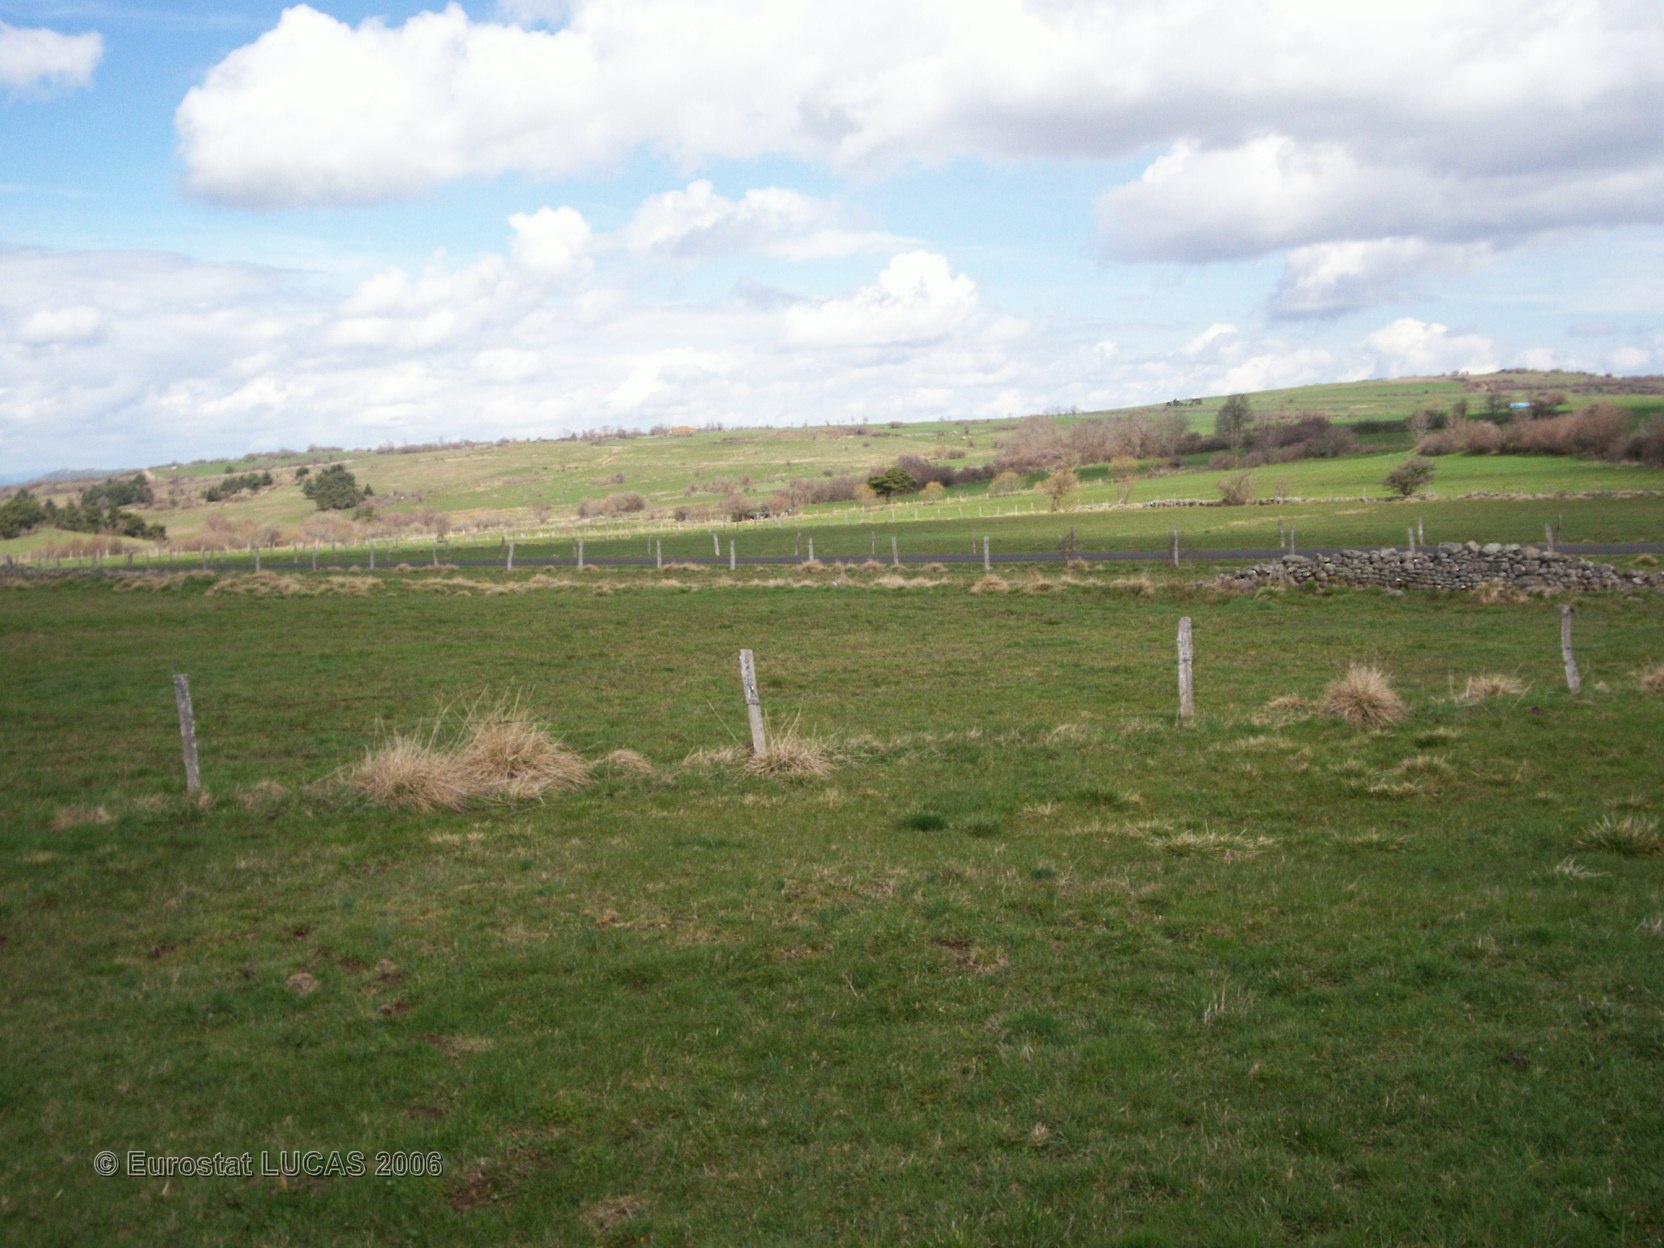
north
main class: Grassland
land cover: Grassland without tree/shrub cover
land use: Agriculture (excluding fallow land and kitchen gardens)
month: April
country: FR
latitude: 45.1077
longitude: 3.2536
